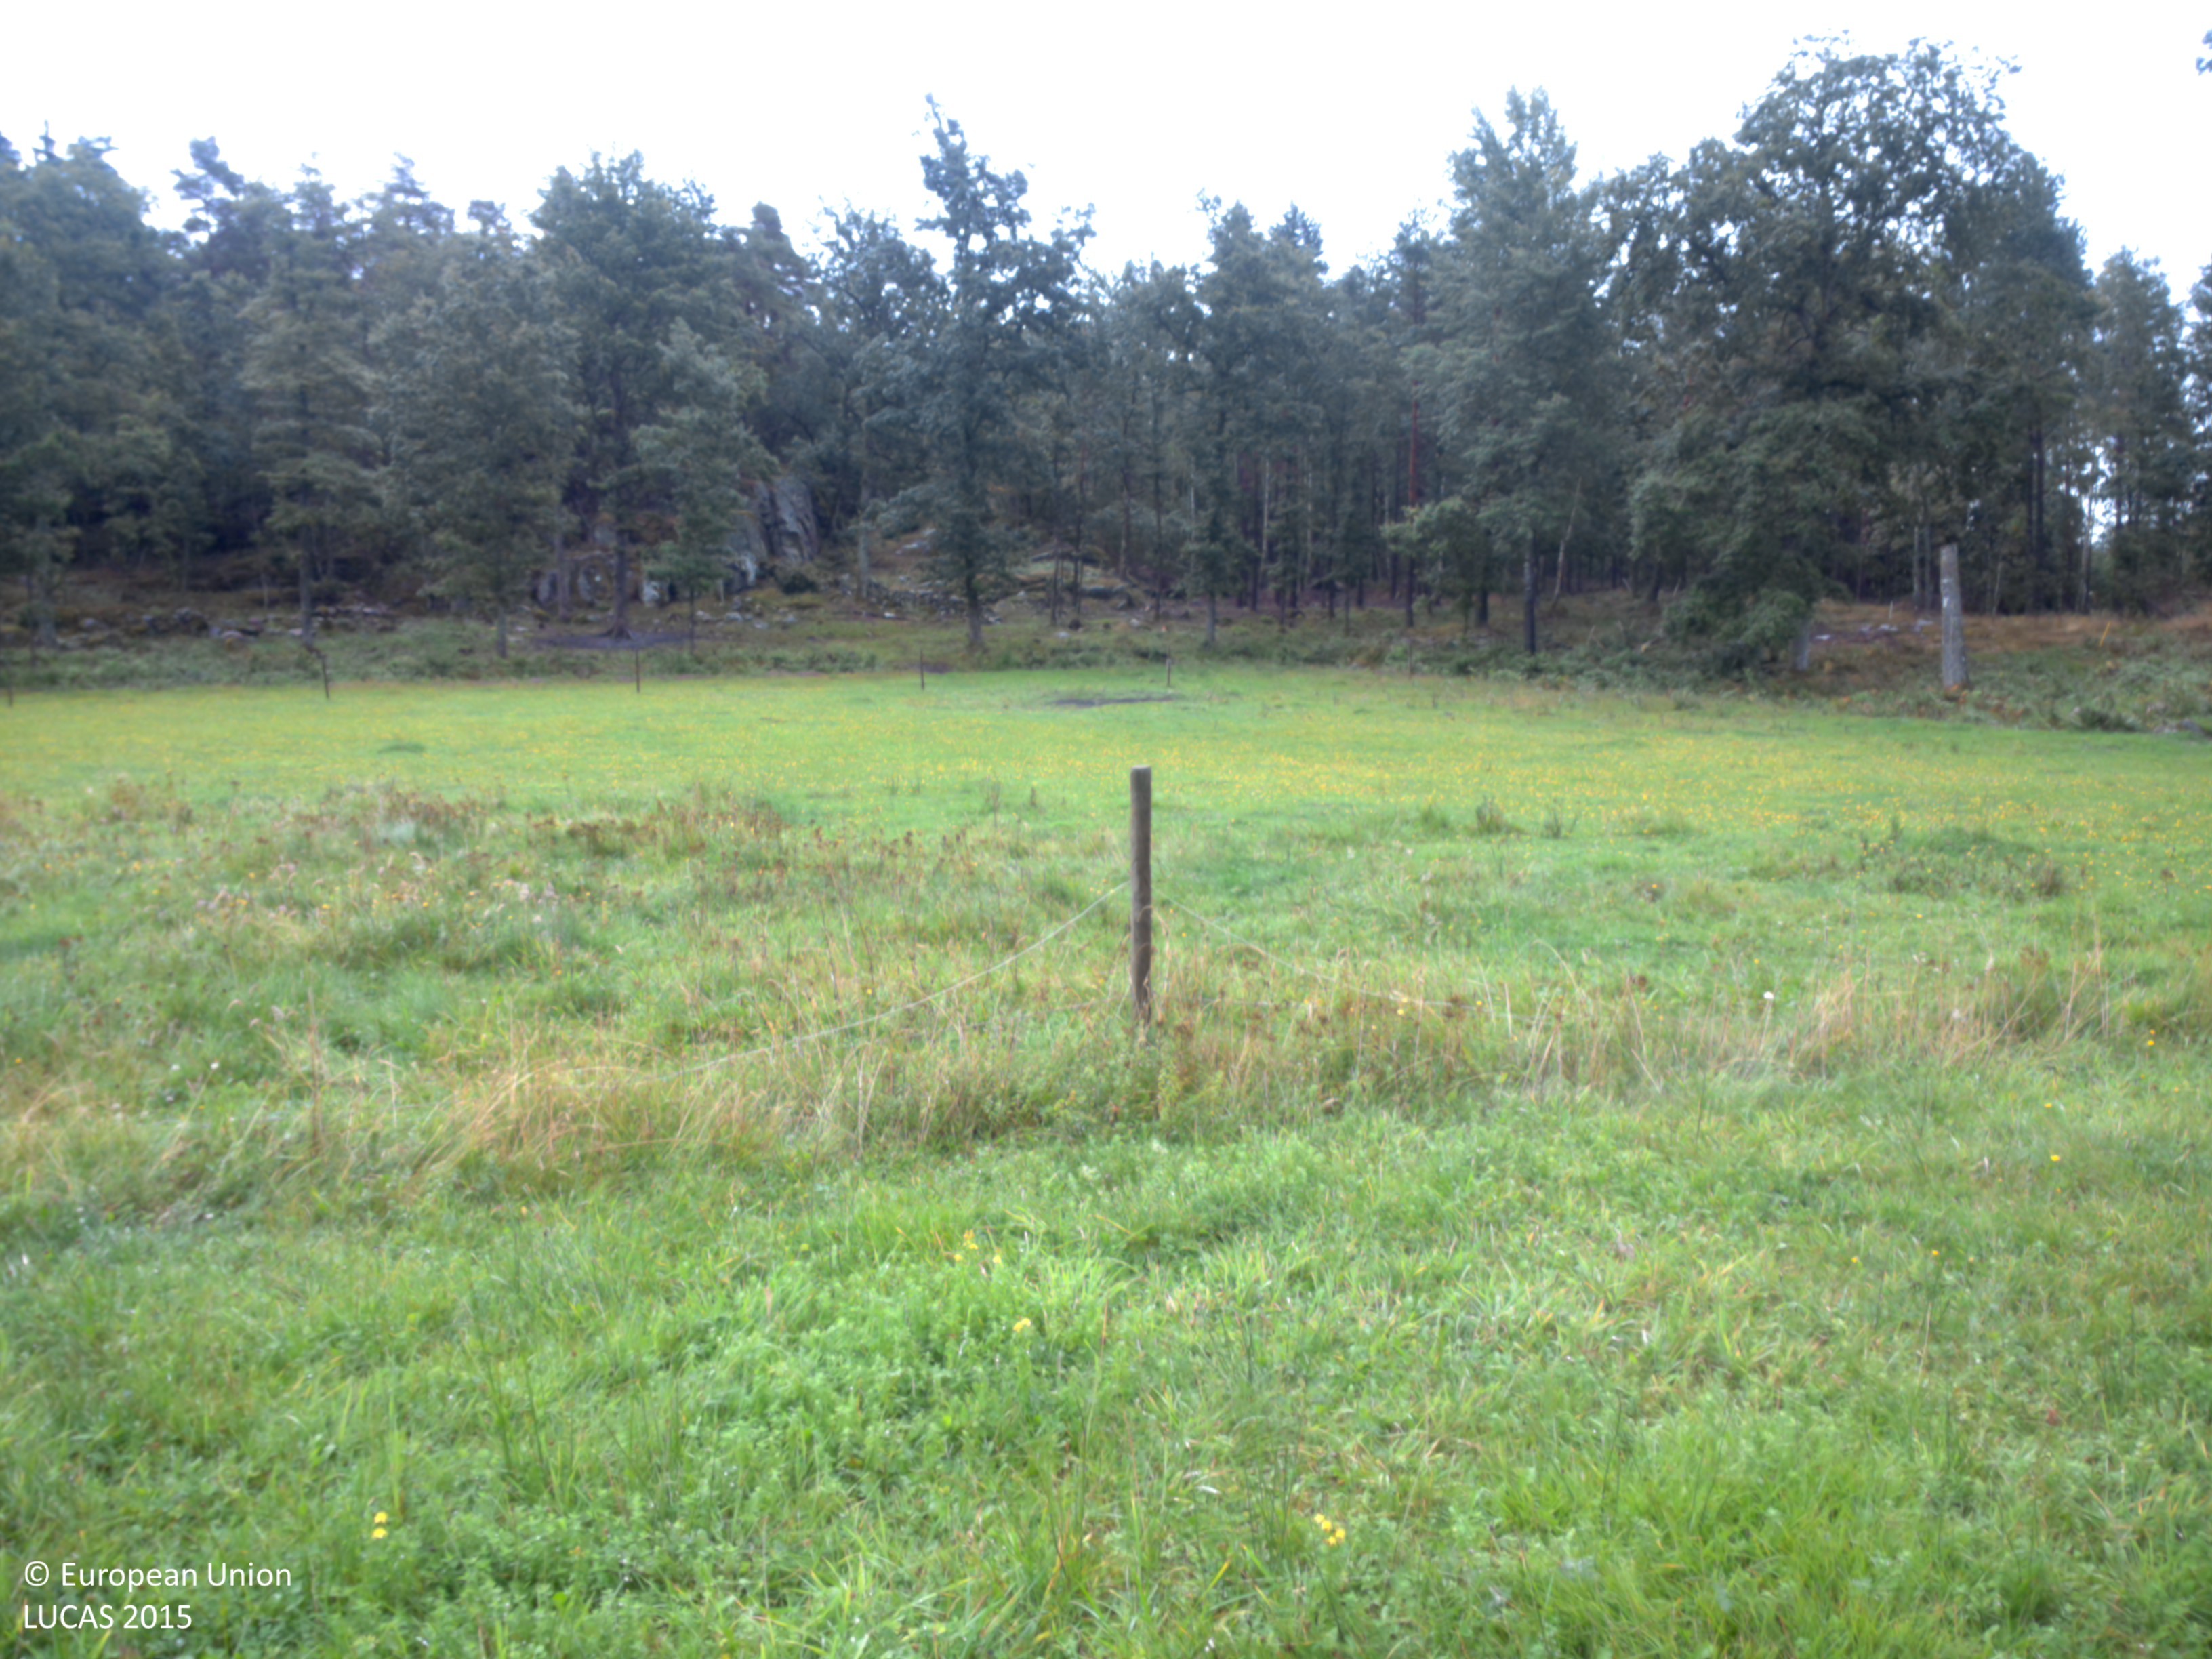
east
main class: Grassland
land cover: Grassland without tree/shrub cover
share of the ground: > 75 %
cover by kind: herbaceous plants 100 %
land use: Agriculture (excluding fallow land and kitchen gardens)
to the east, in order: Grassland without tree/shrub cover; Fences; Grassland without tree/shrub cover; Ditches and canals; Broadleaved woodland; Dry stone walls; Fences; Broadleaved woodland; Fences; Broadleaved woodland; Spruce dominated mixed woodland; Rock outcrops; Spruce dominated mixed woodland
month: August
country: SE
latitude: 58.1095
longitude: 12.3208
